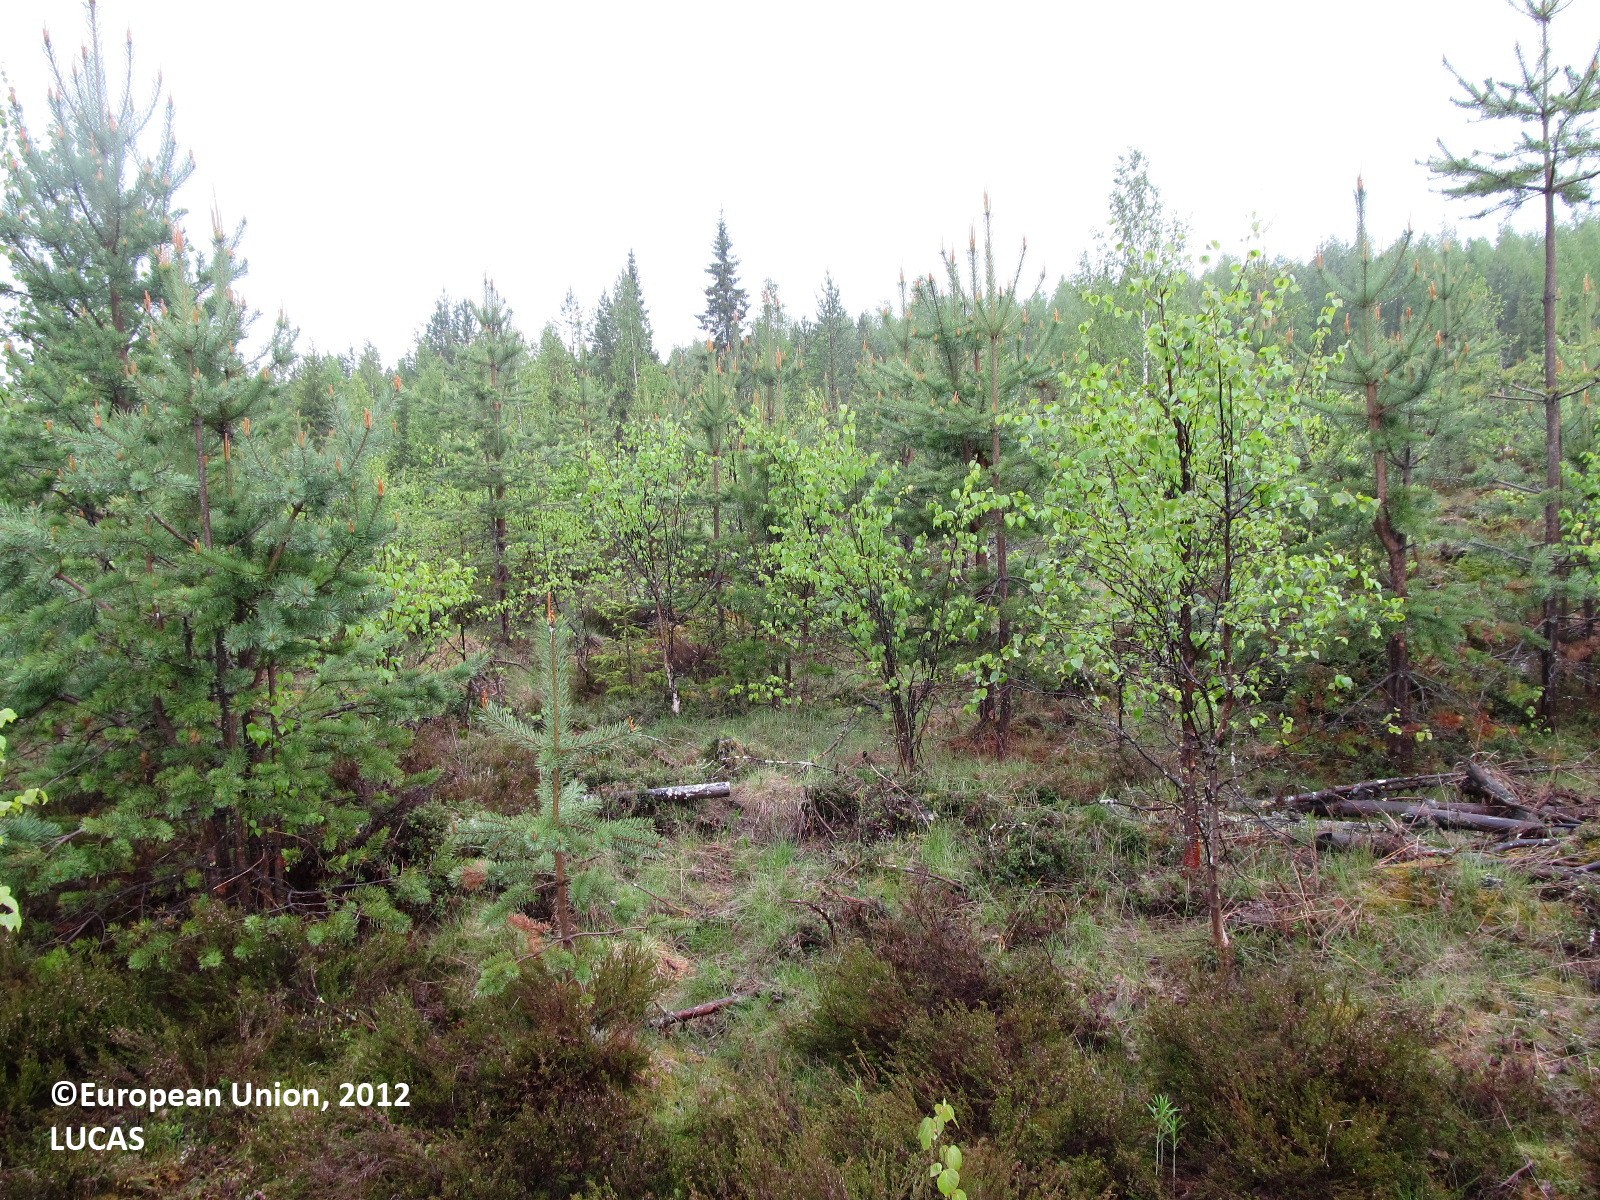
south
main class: Woodland
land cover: Pine dominated mixed woodland
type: boreal forest
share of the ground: 10 - 25 %
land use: Forestry
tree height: < 5 m
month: June
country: FI
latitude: 63.3102
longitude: 28.8220
